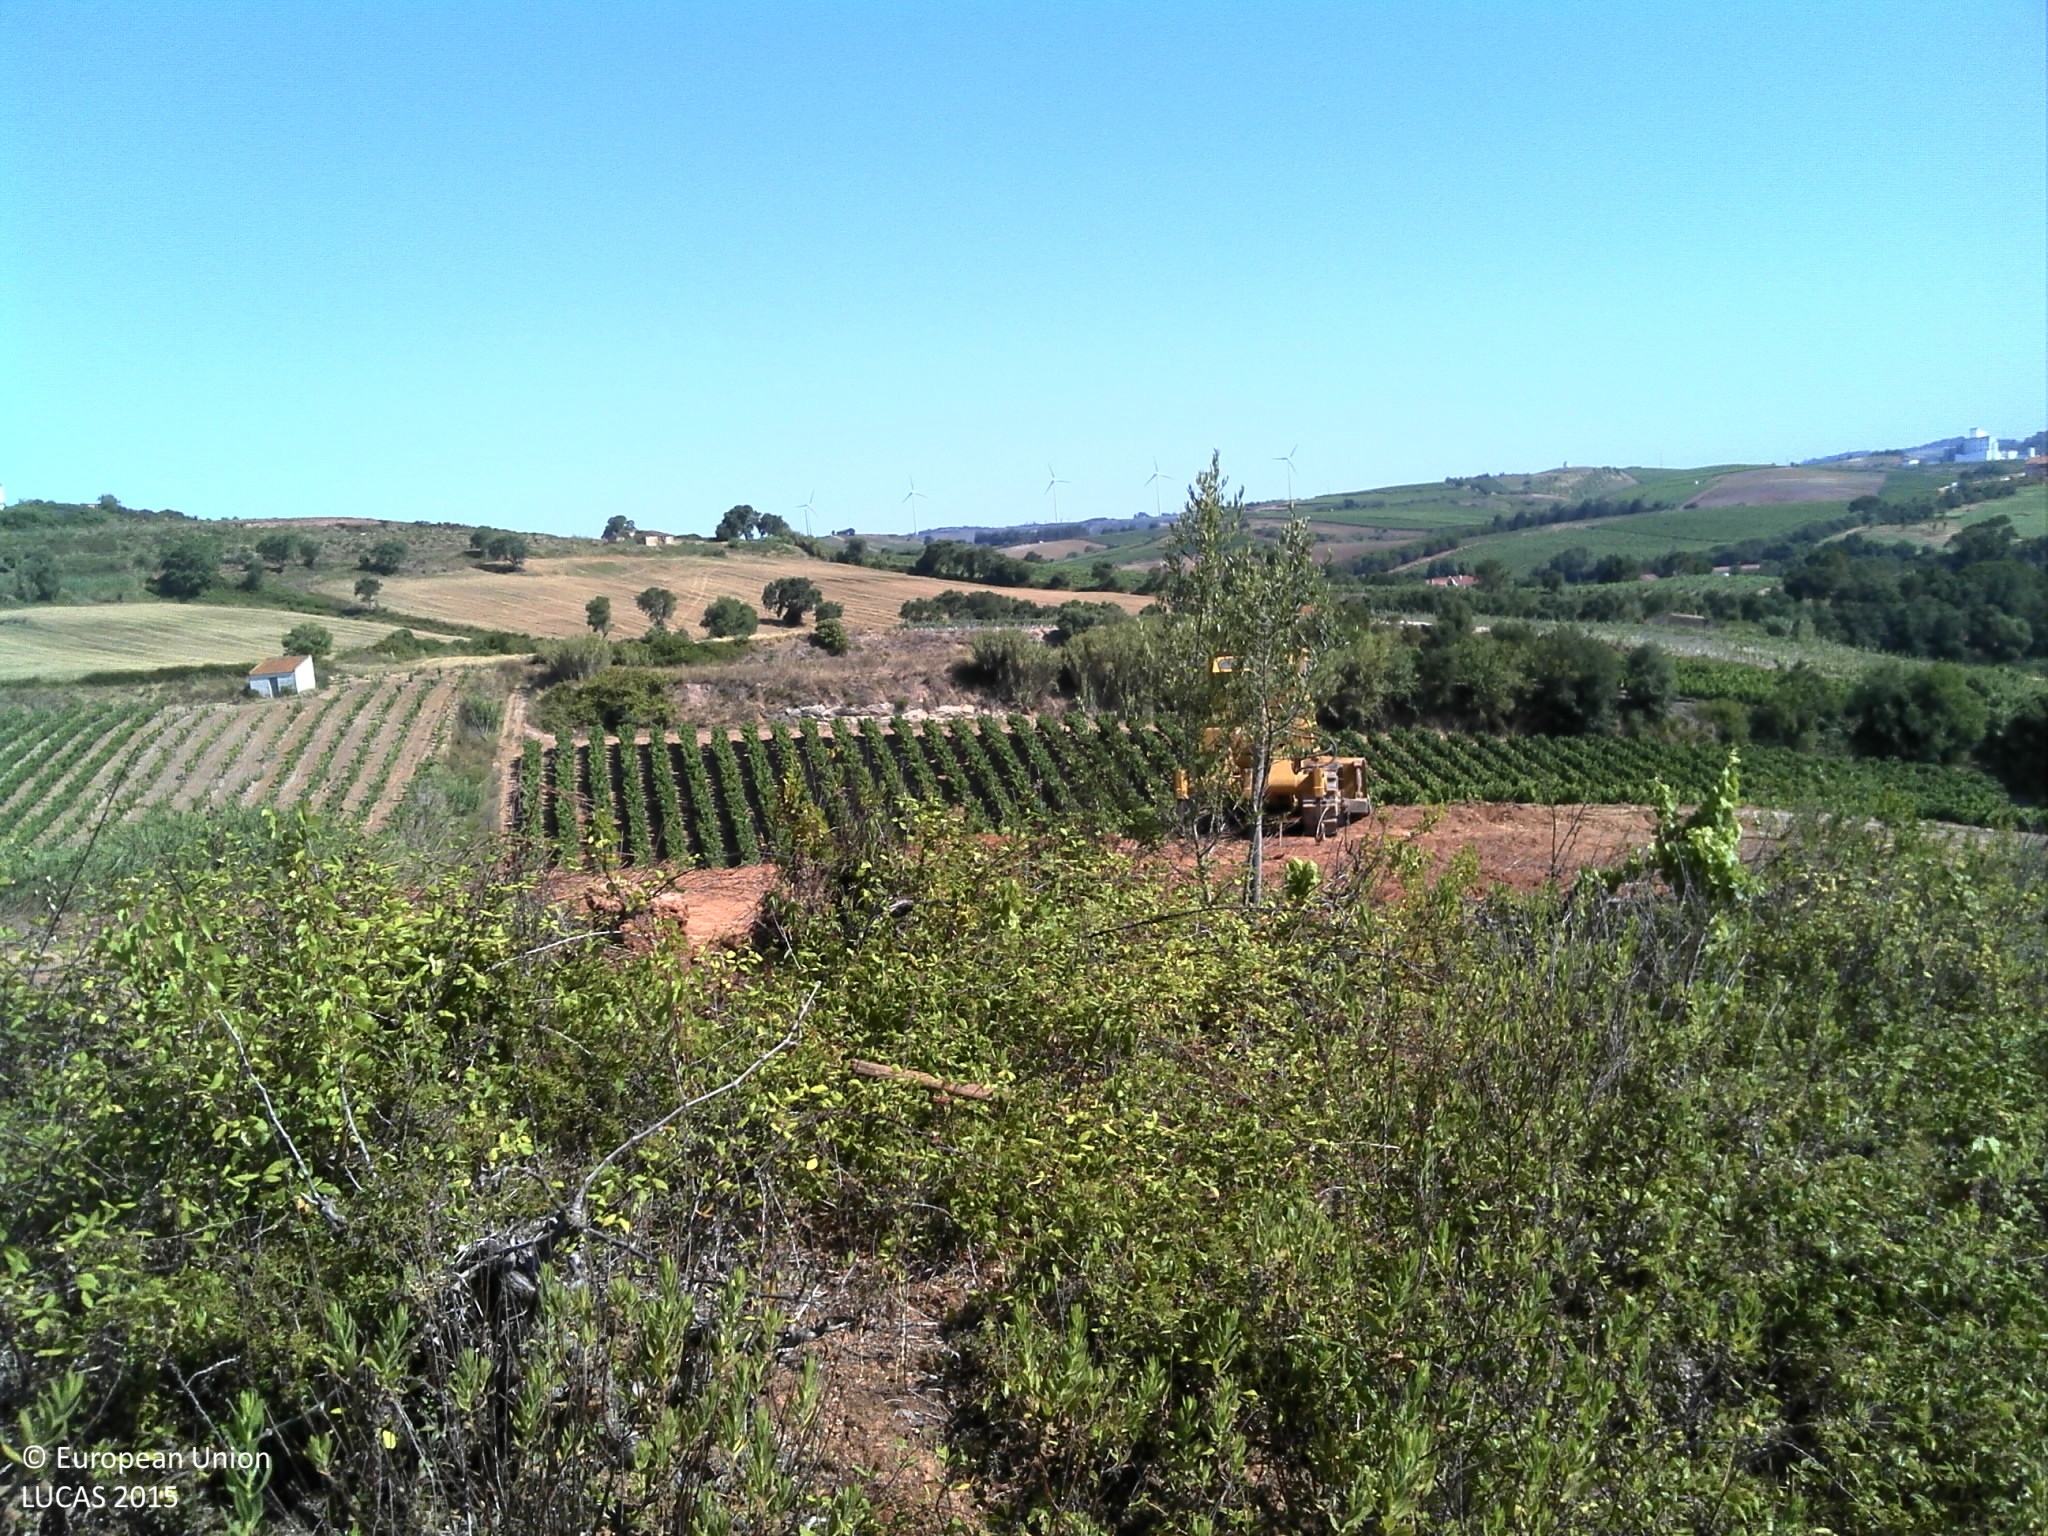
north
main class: Shrubland
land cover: Shrubland without tree cover
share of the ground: 50 - 75 %
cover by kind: shrubs 60 %, unconsolidated bare surface 30 %, herbaceous plants 10 %
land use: Semi-natural and natural areas not in use
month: June
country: PT
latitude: 39.0269
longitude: -9.2478
